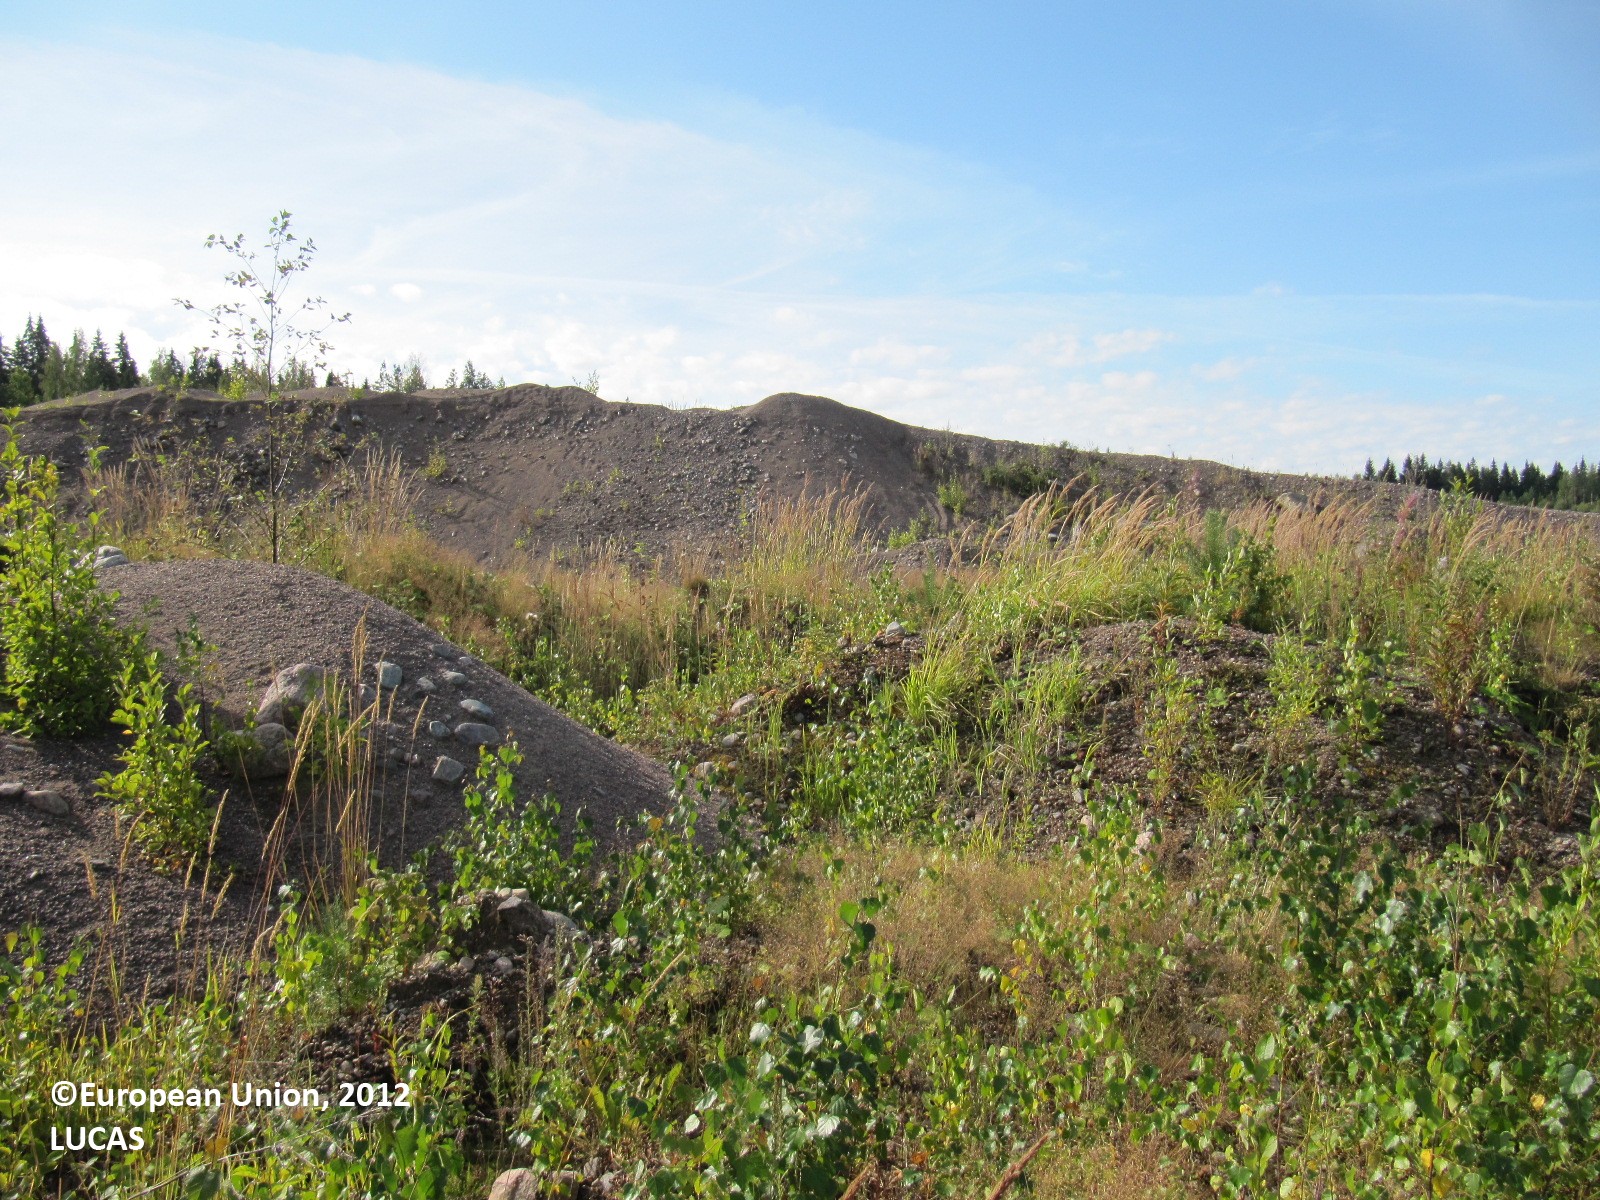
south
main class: Woodland
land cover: Other mixed woodland
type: boreal forest
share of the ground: > 75 %
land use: Mining and quarrying
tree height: < 5 m
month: August
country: FI
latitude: 60.5148
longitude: 24.4392
